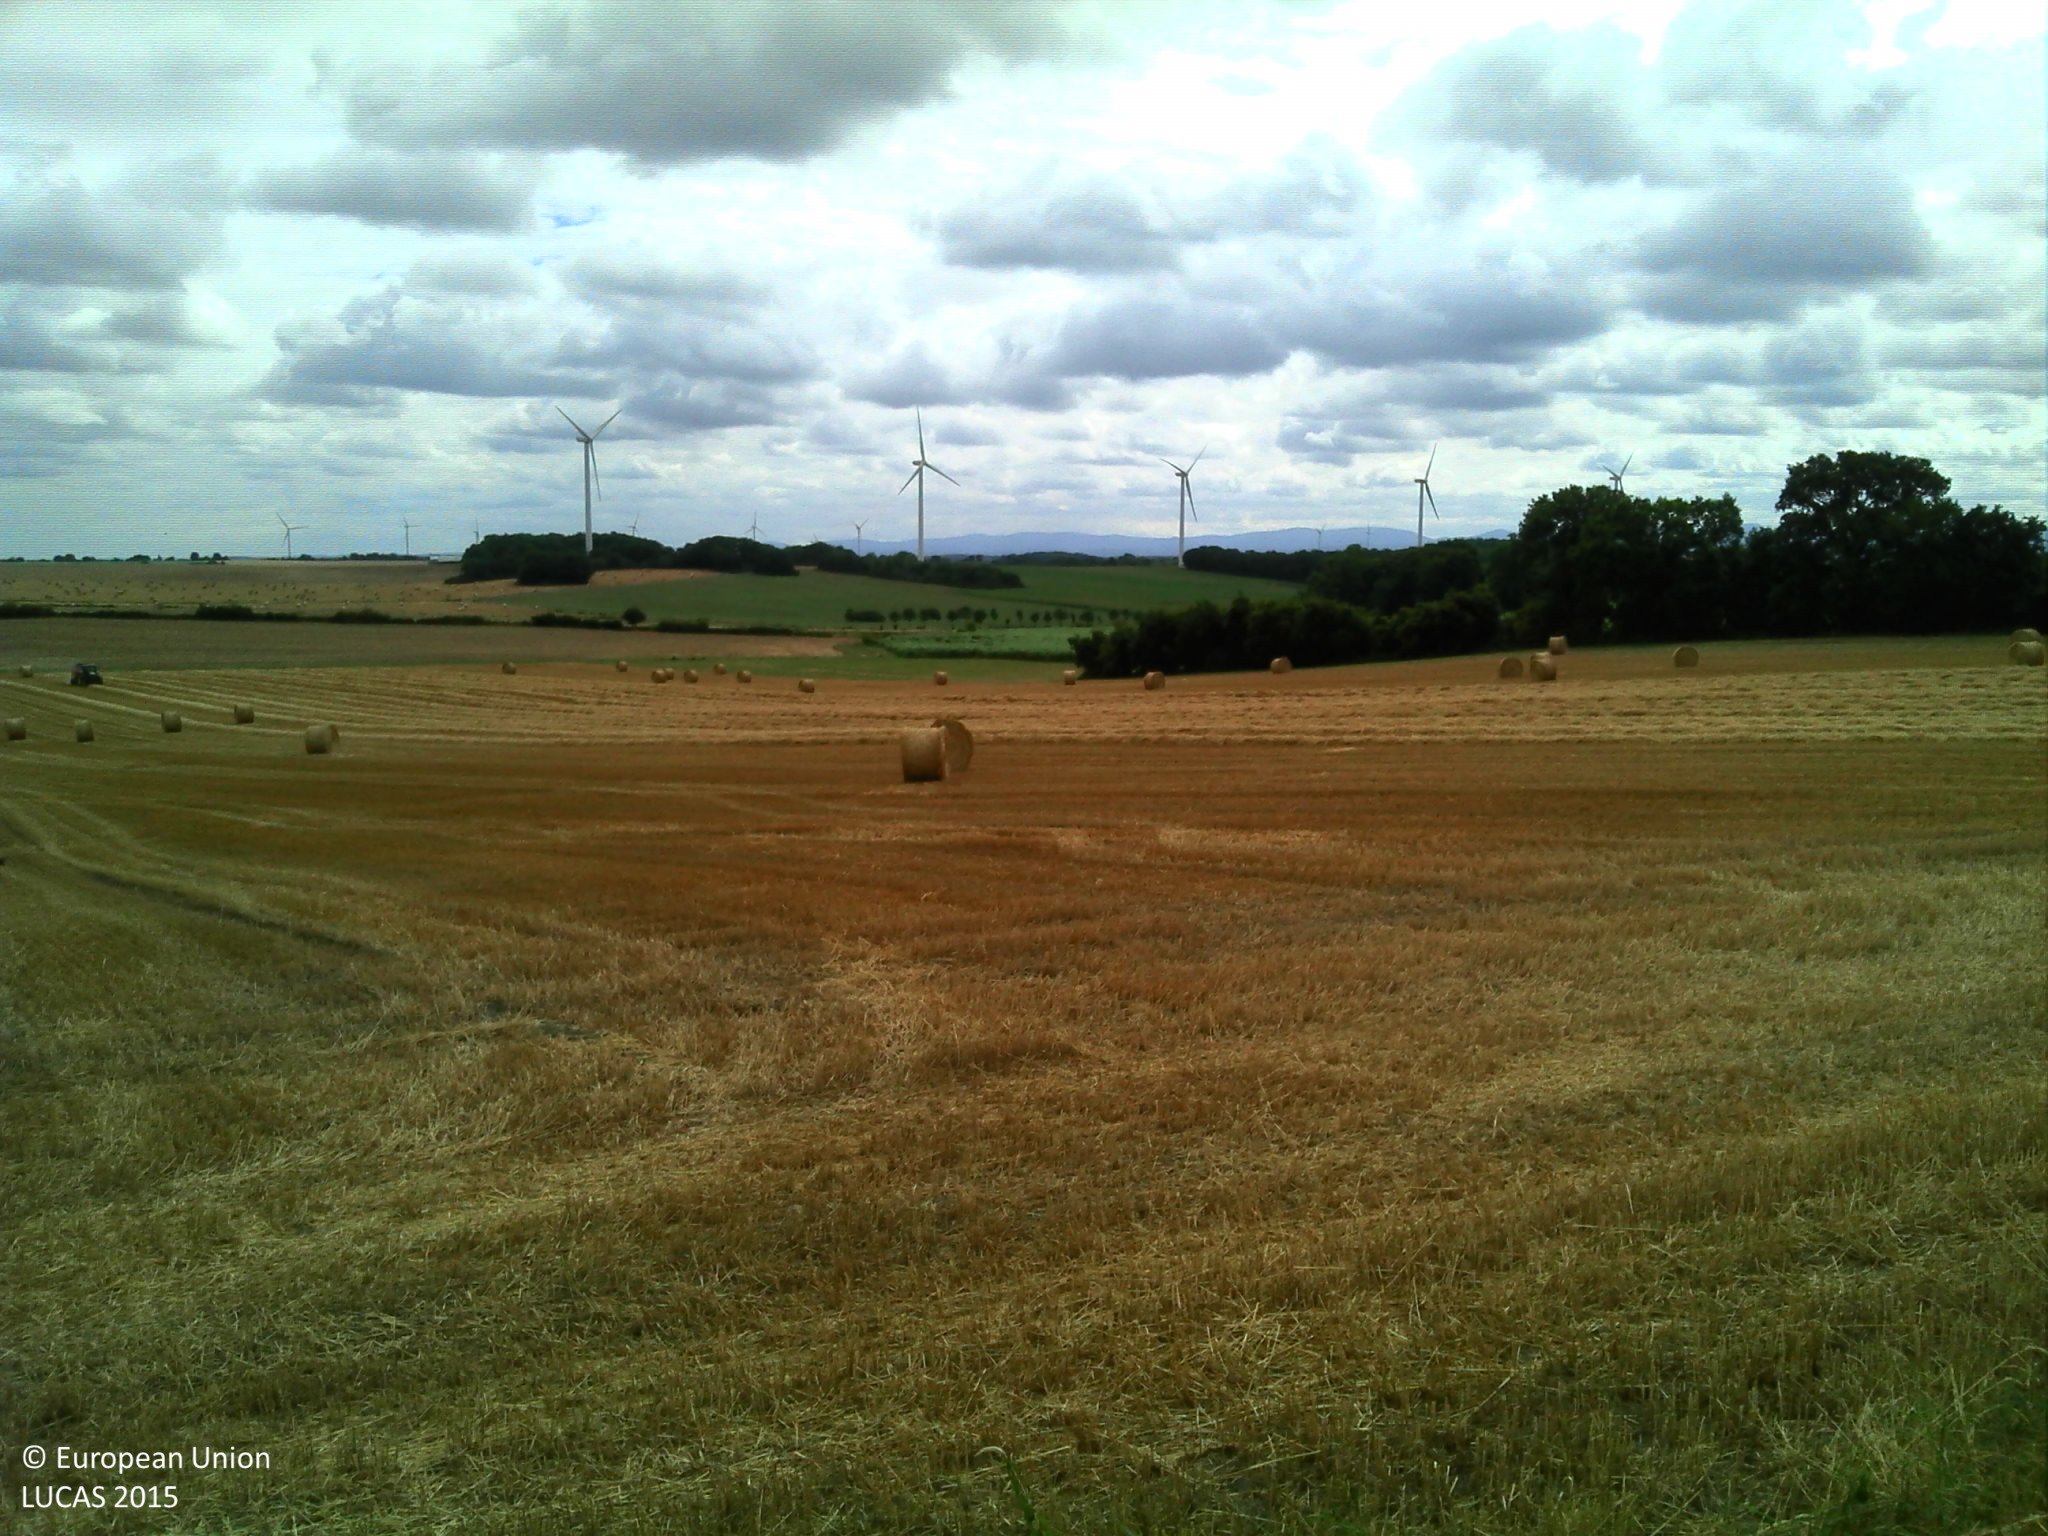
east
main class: Cropland
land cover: Common wheat
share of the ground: > 75 %
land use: Agriculture (excluding fallow land and kitchen gardens)
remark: Harvested field
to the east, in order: Paved roads, cycling and walking lanes; Grass margins; Common wheat
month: July
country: FR
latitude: 48.6277
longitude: 6.8121
